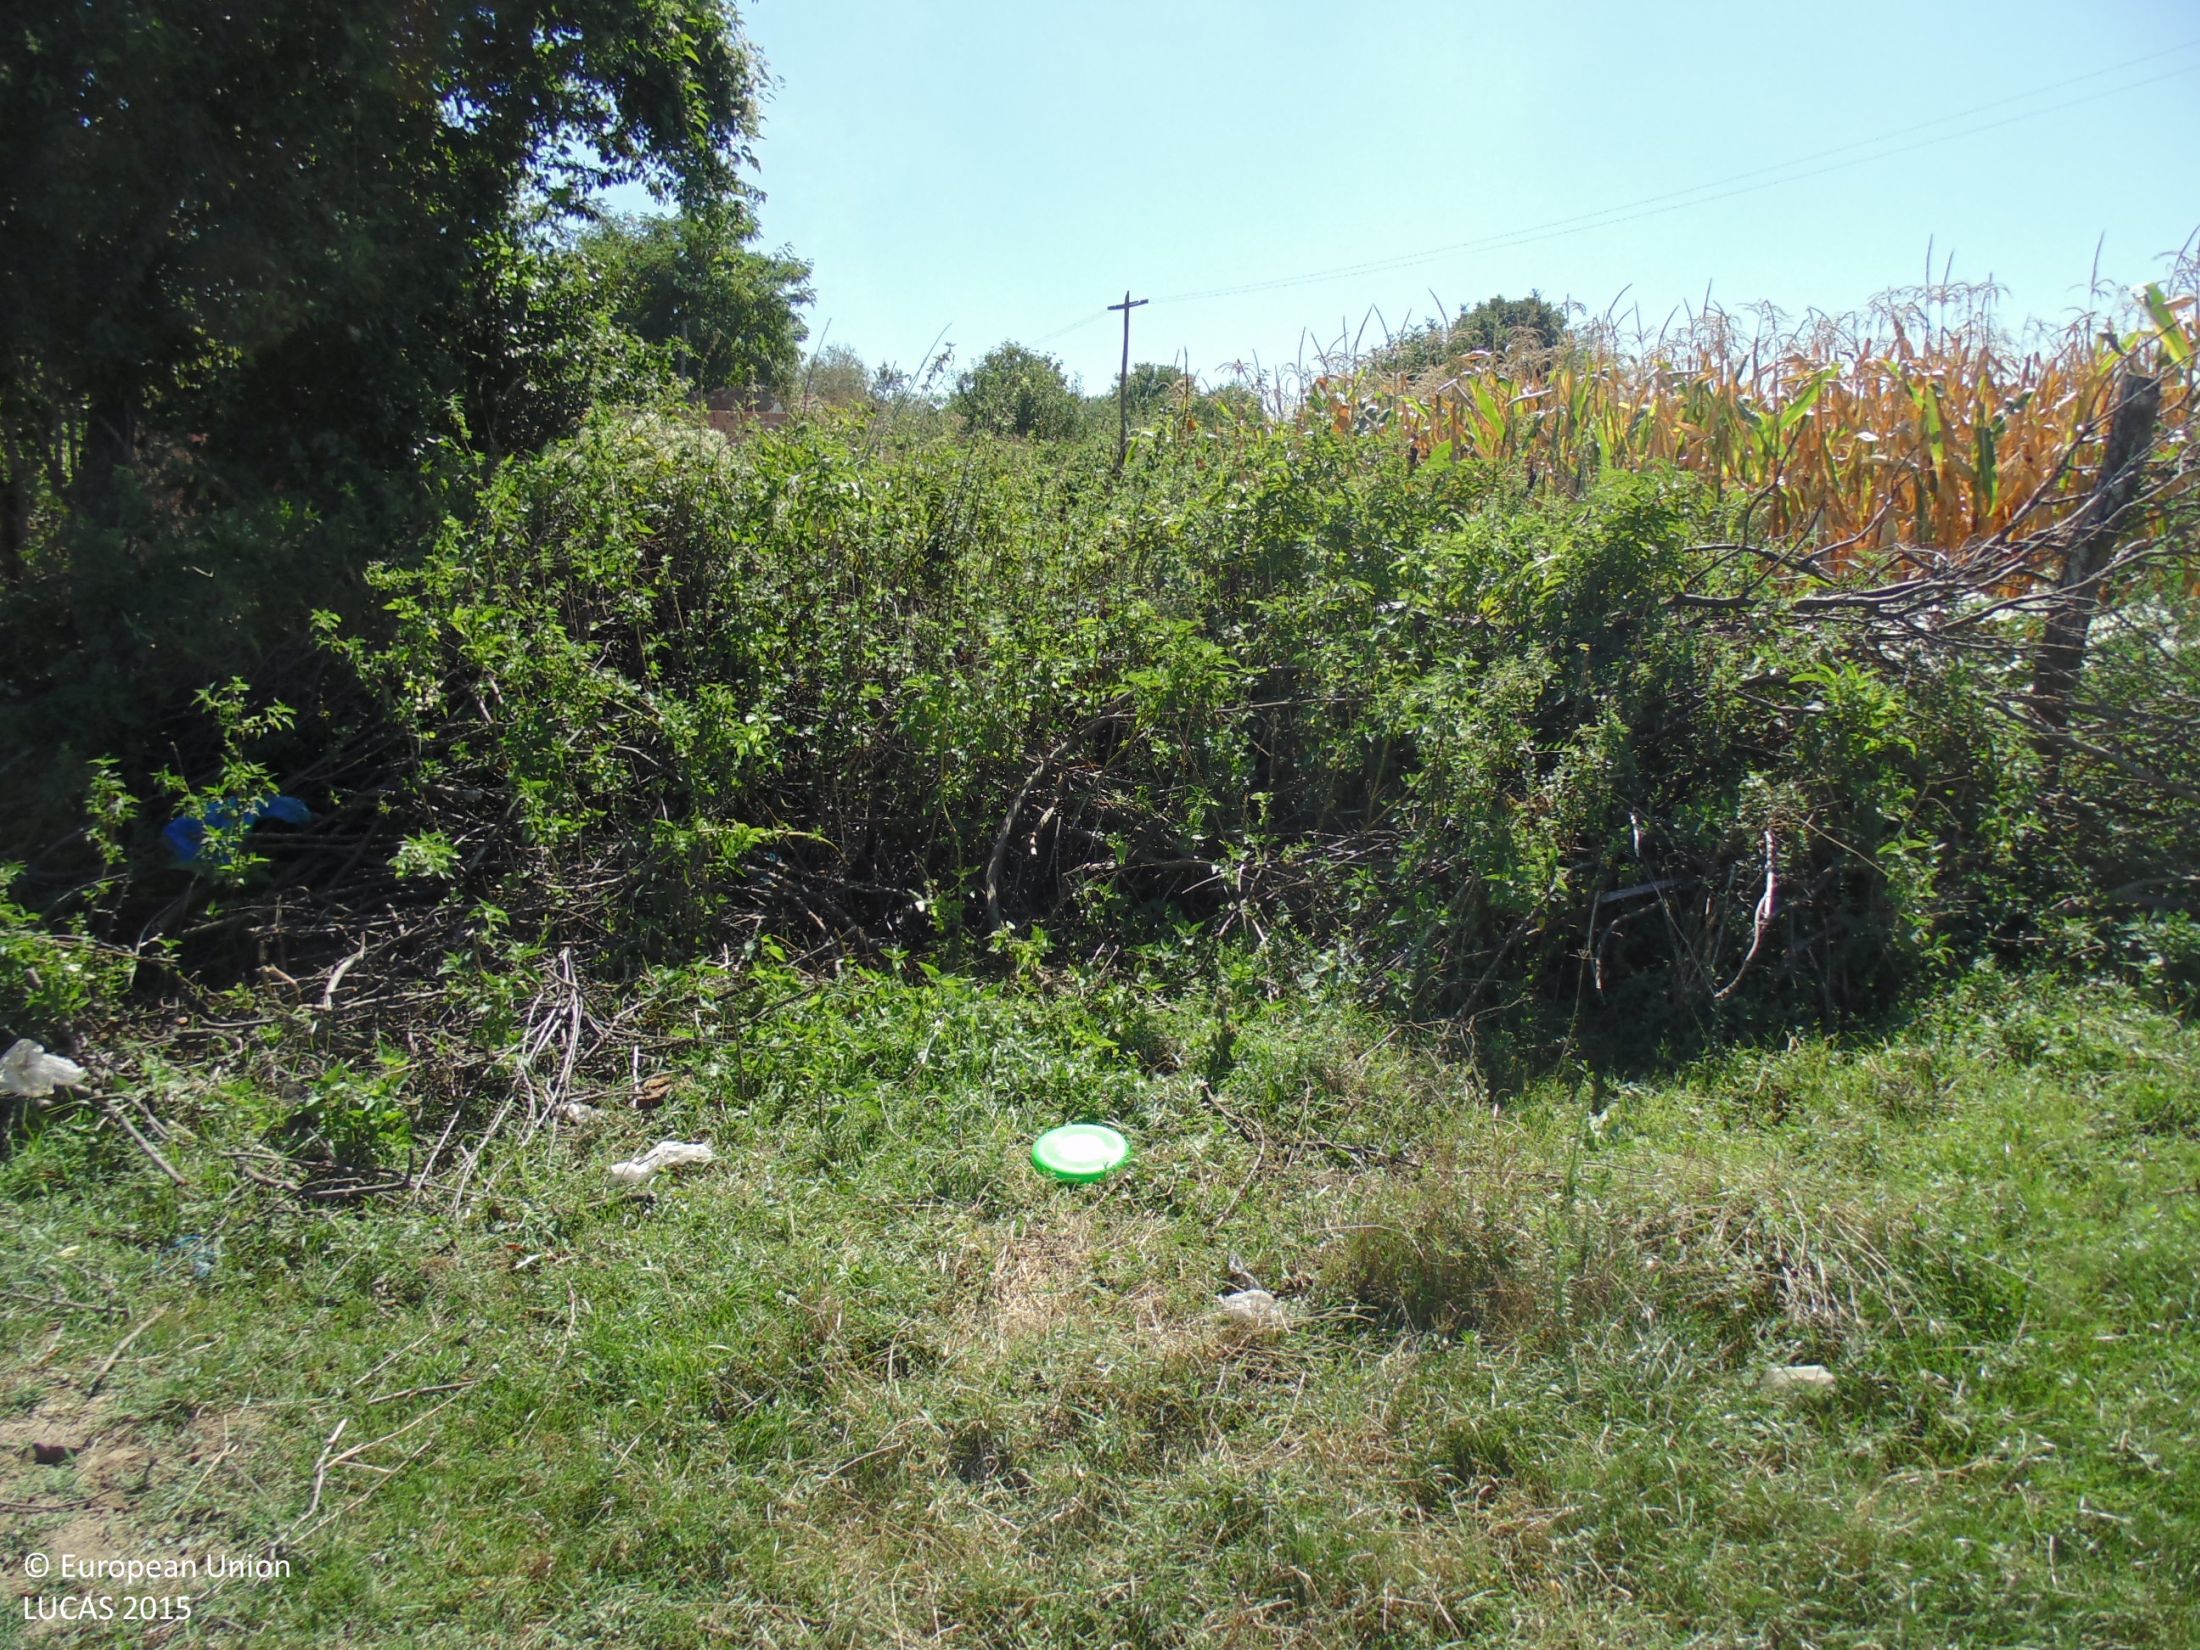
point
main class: Grassland
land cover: Grassland with sparse tree/shrub cover
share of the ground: > 75 %
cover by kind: herbaceous plants 90 %, broadleaved forest trees 5 %, shrubs 5 %
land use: Residential
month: September
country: BG
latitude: 43.8168
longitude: 27.1199
